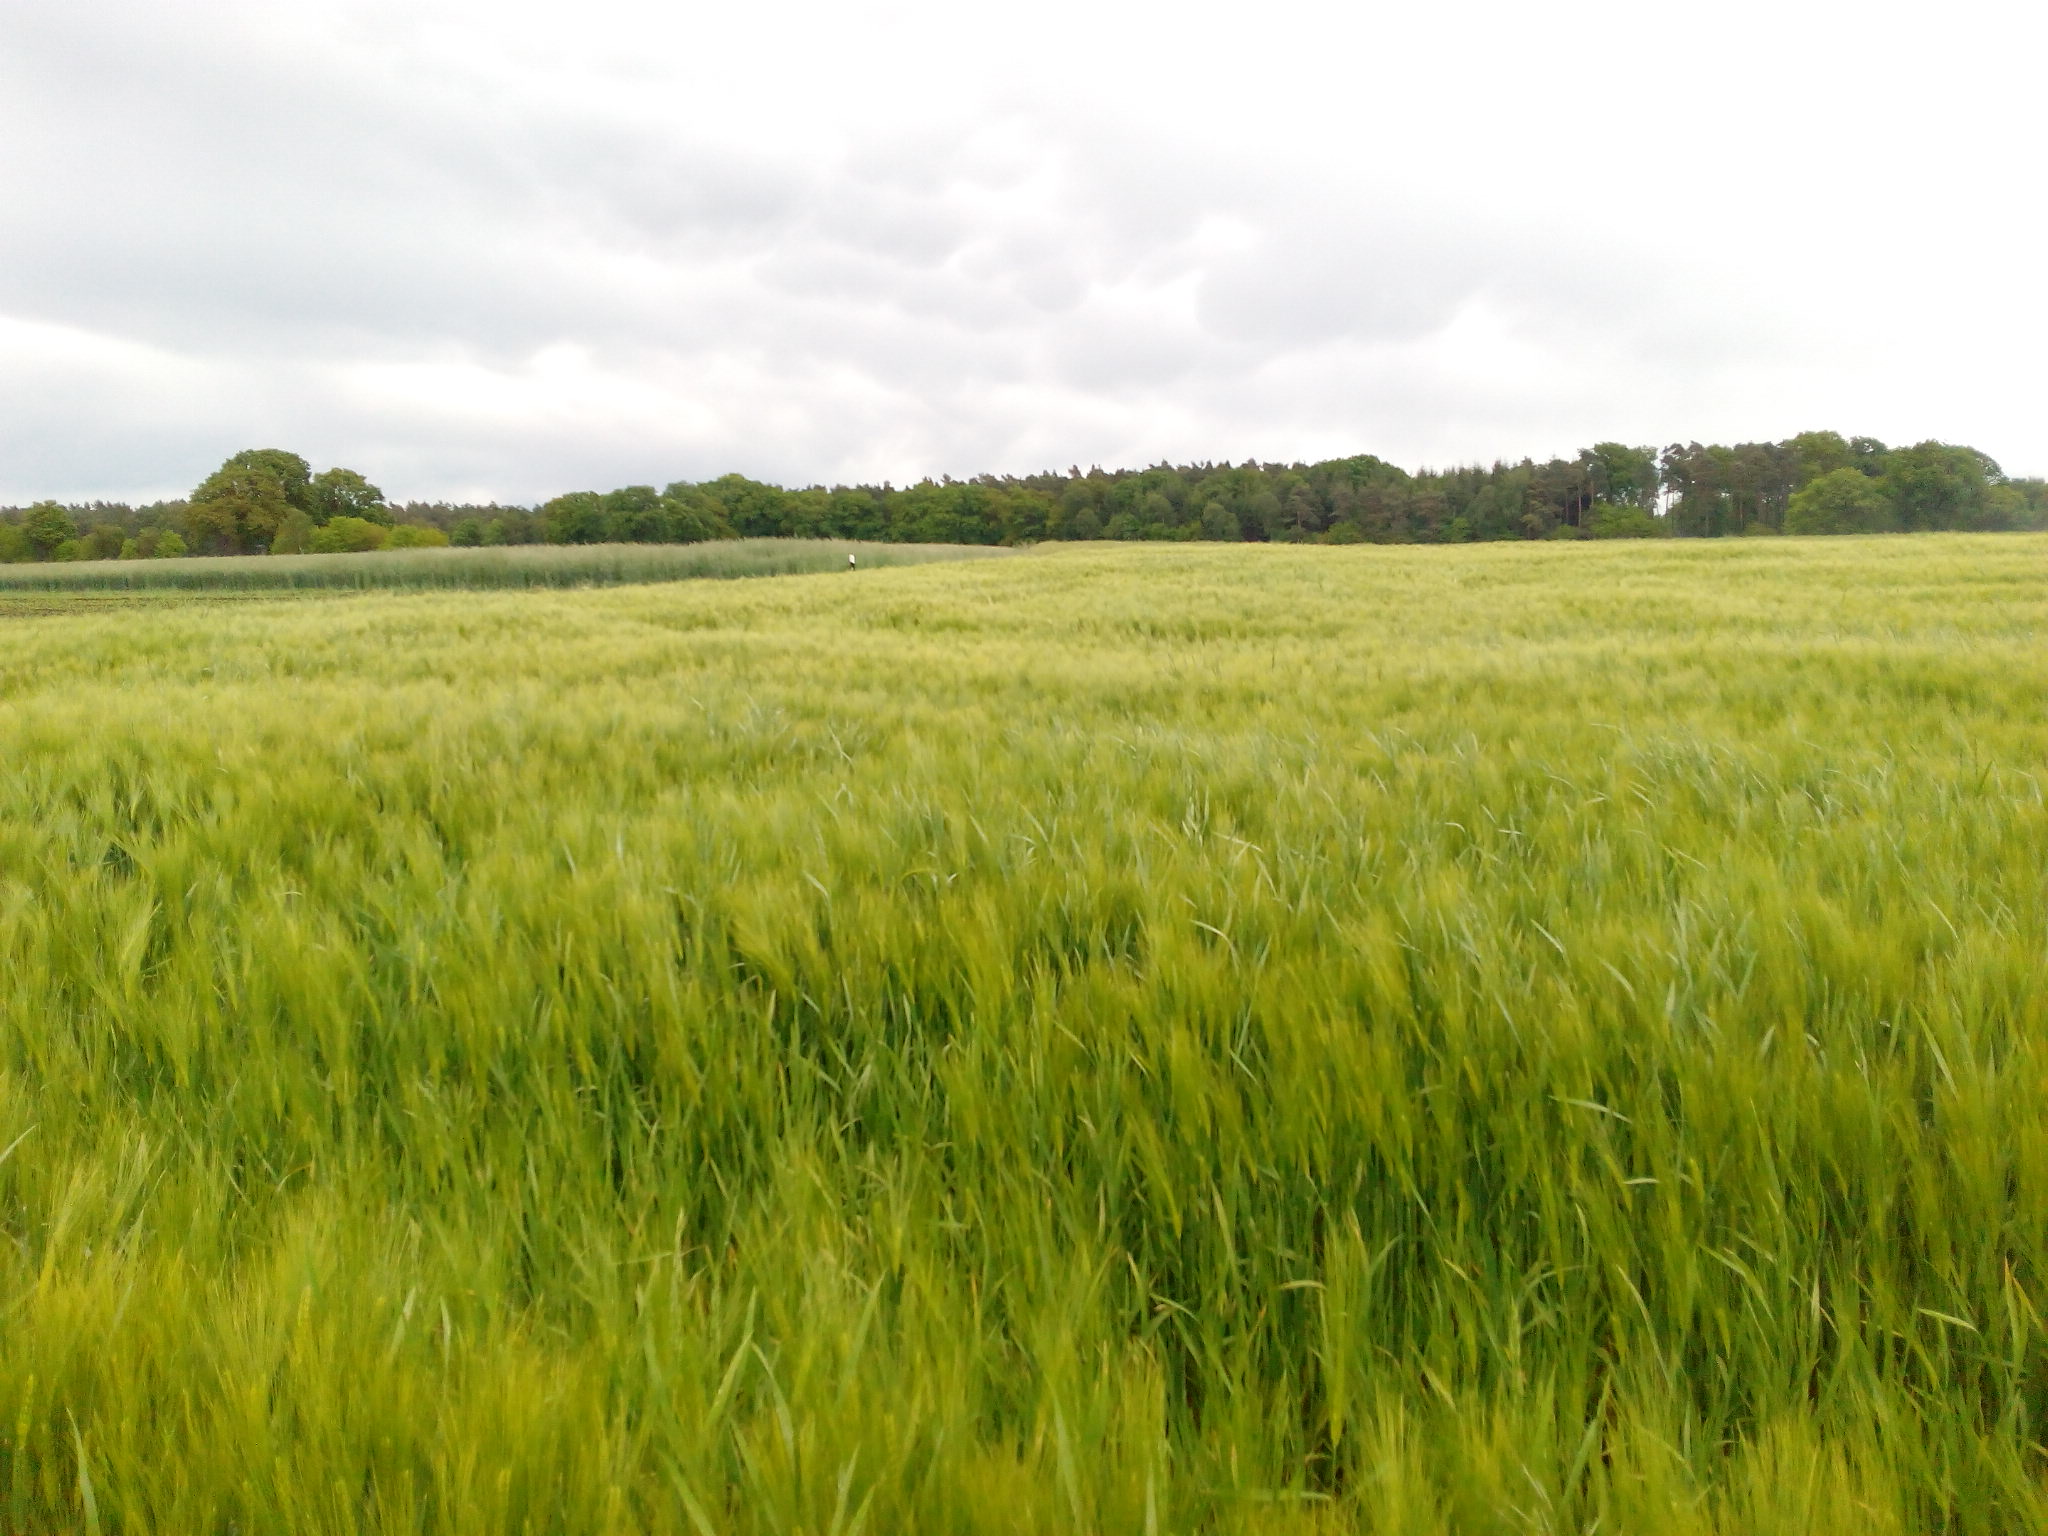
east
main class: Cropland
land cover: Barley
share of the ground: > 75 %
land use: Agriculture (excluding fallow land and kitchen gardens)
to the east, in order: Barley; Rape and turnip rape; Common wheat
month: May
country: DE
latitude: 52.7347
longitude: 9.2746
